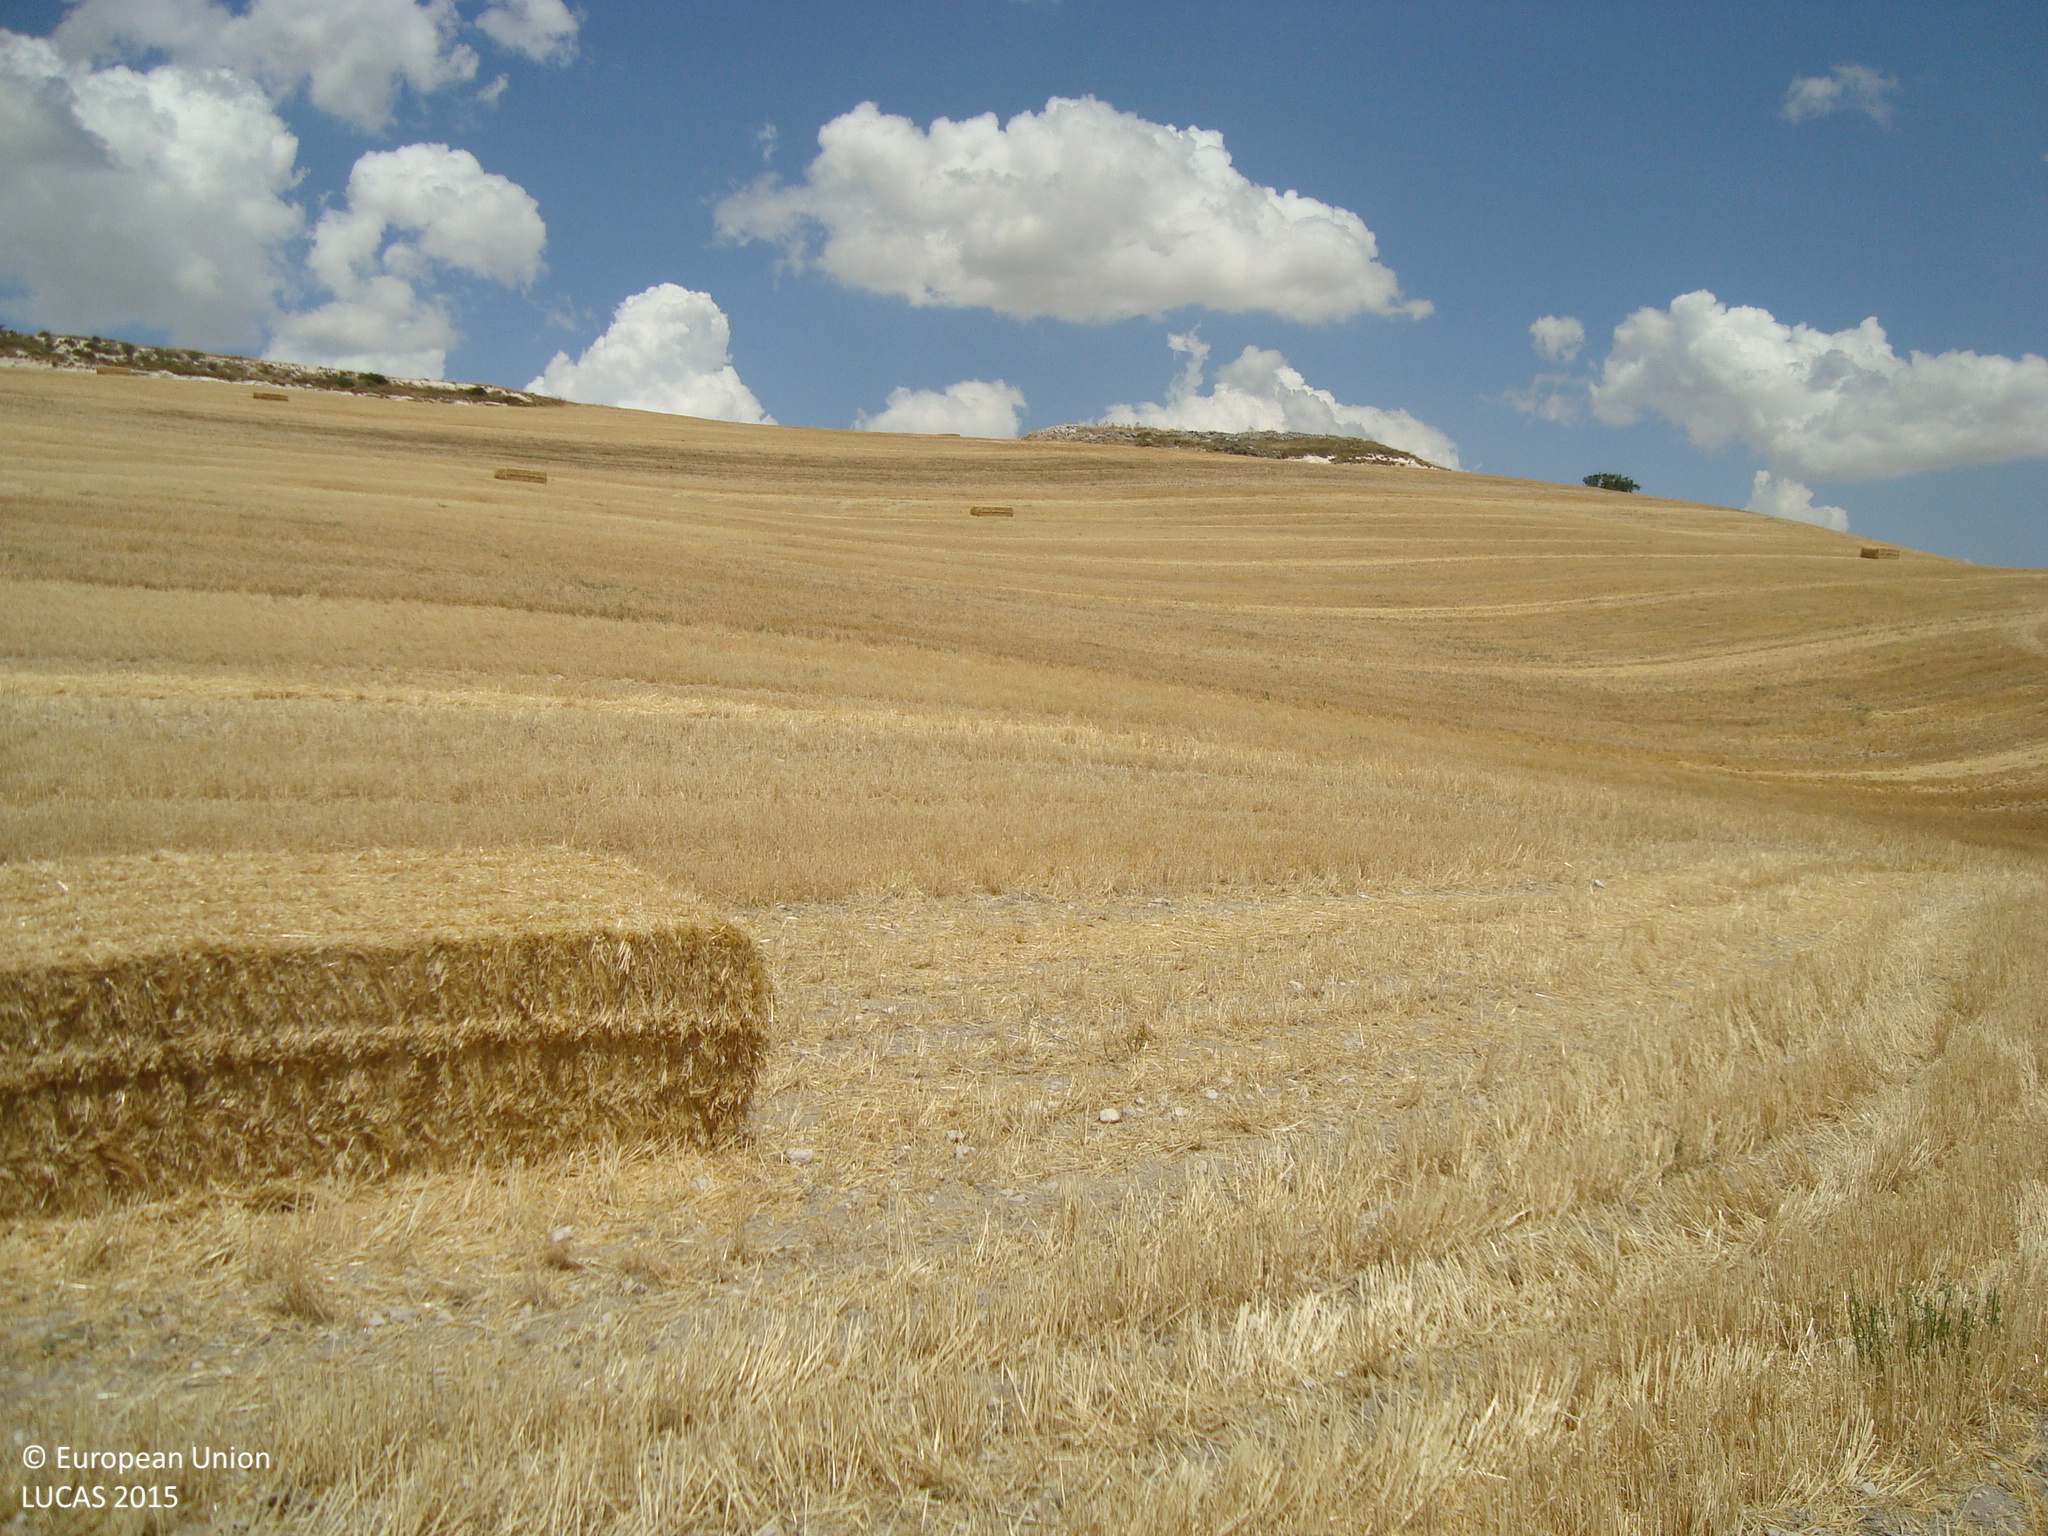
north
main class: Cropland
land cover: Barley
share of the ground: > 75 %
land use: Agriculture (excluding fallow land and kitchen gardens)
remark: Harvested field
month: July
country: ES
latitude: 41.9568
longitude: -4.2161
